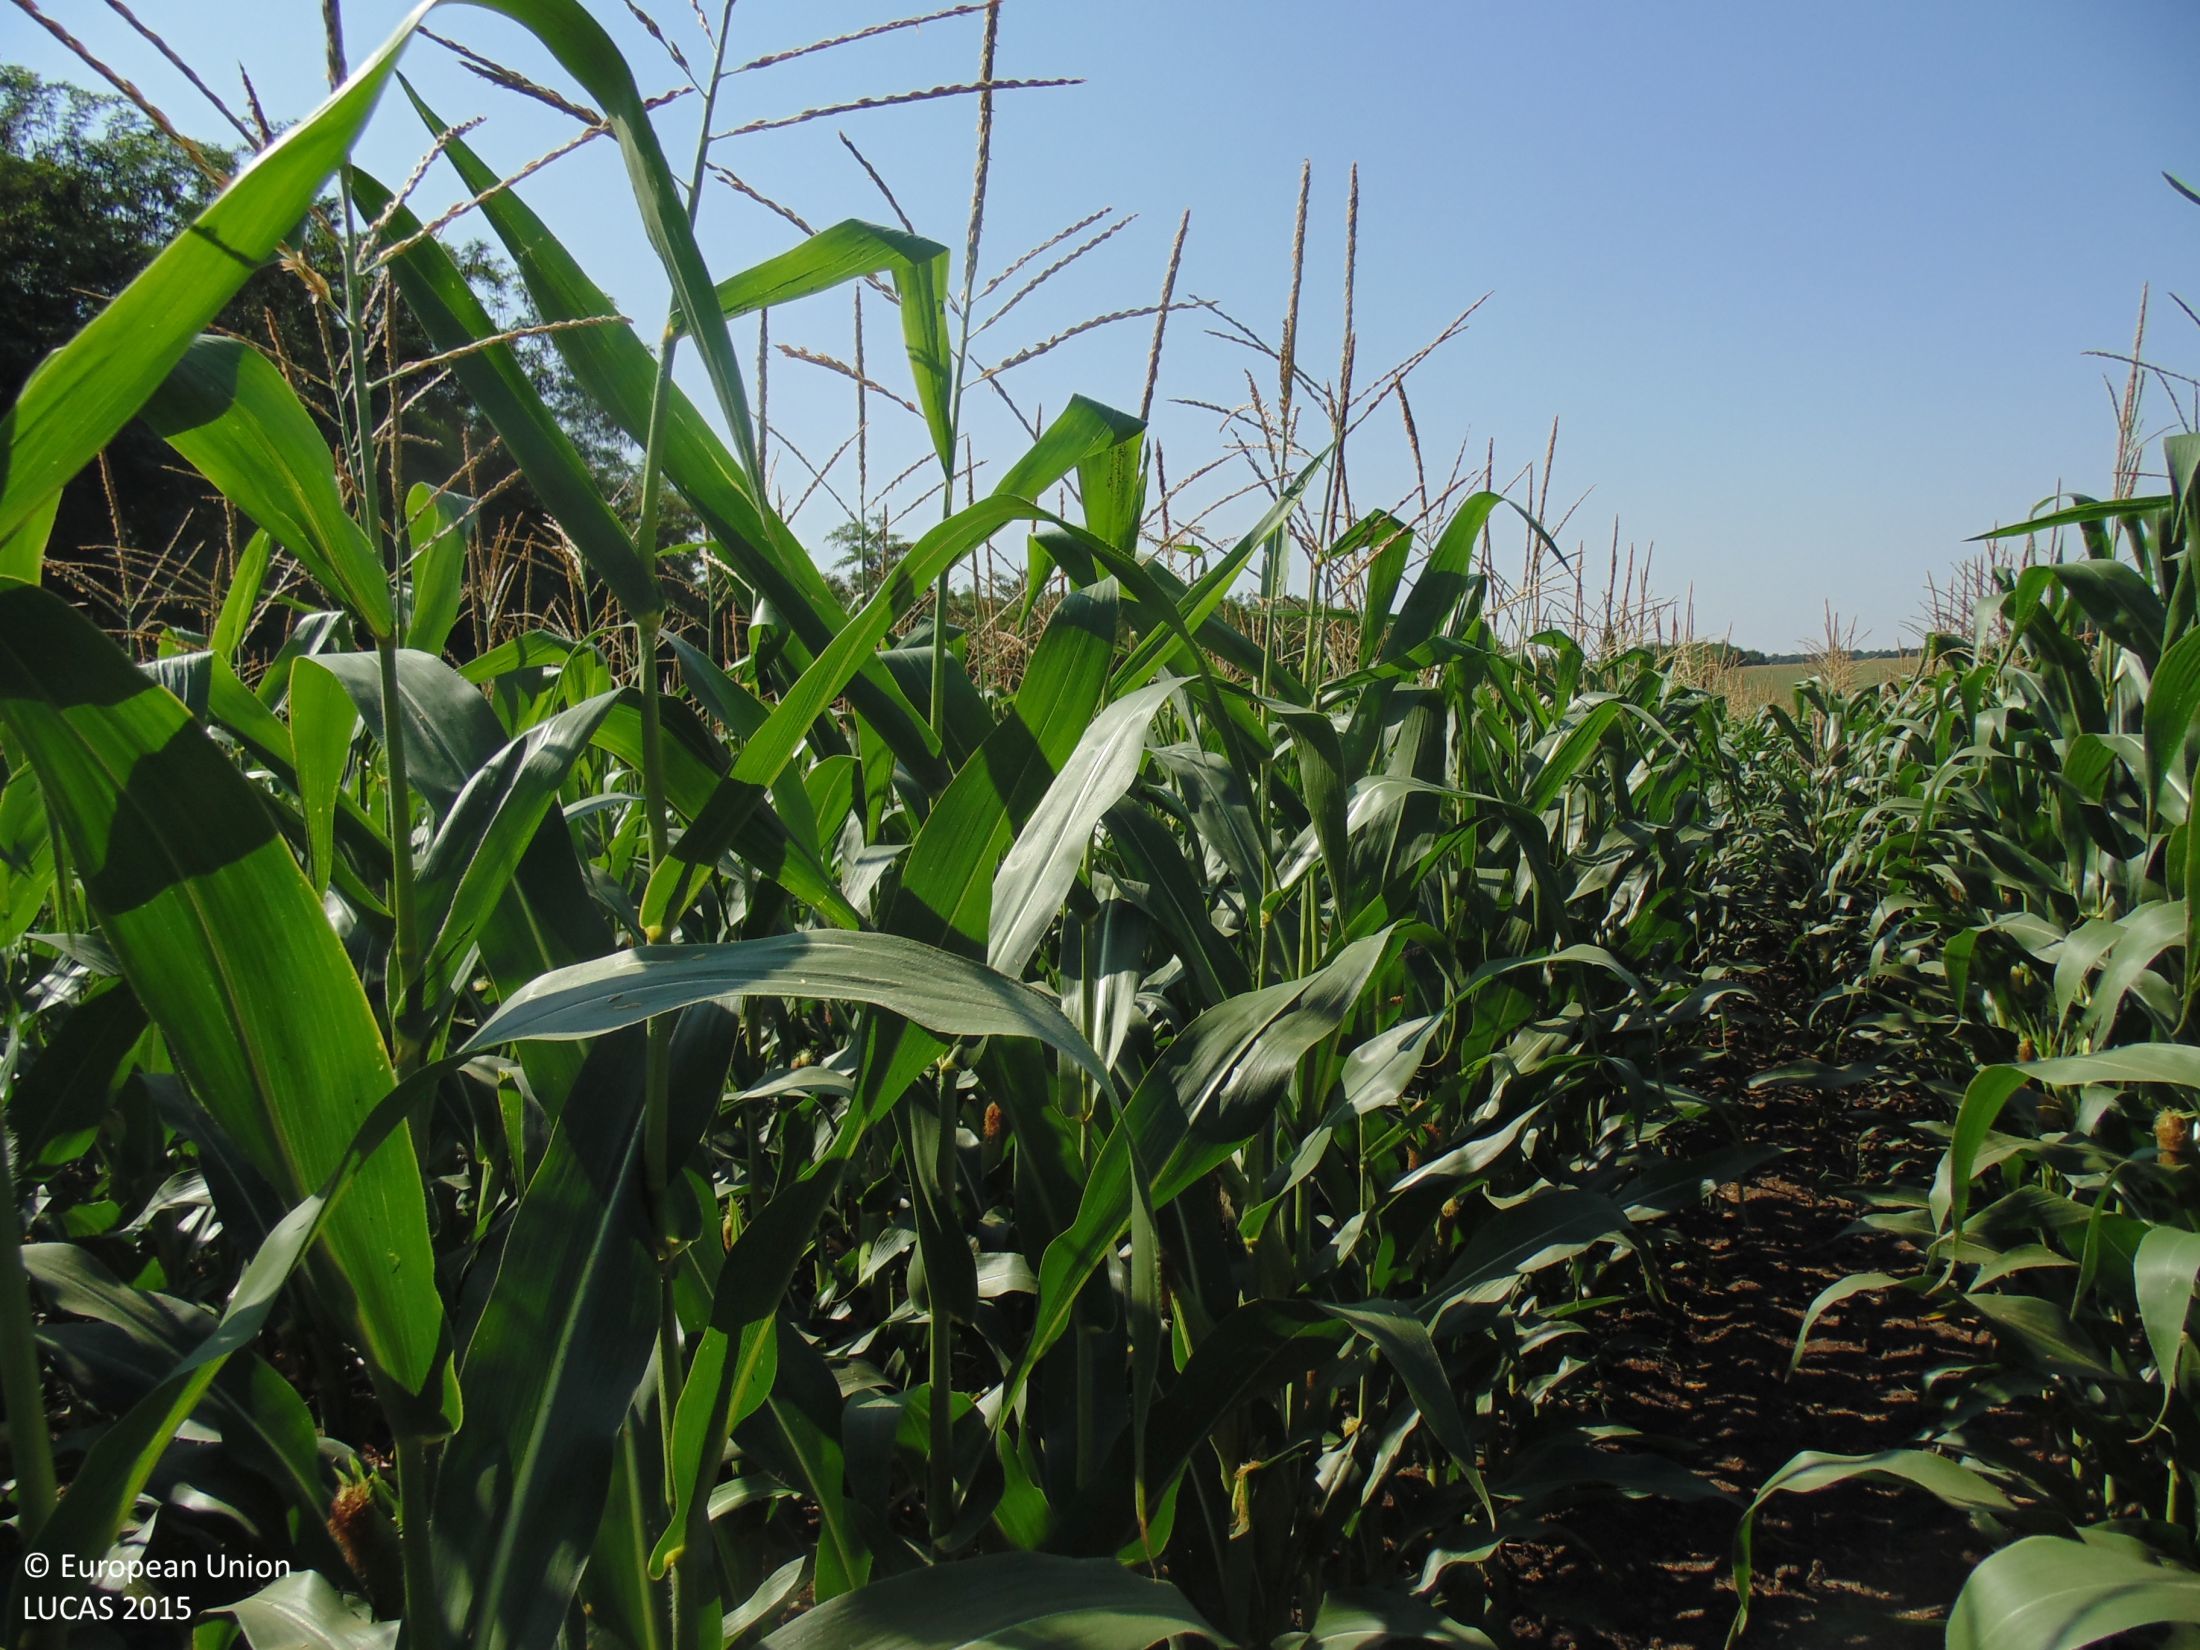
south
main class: Cropland
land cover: Maize
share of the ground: > 75 %
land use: Agriculture (excluding fallow land and kitchen gardens)
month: July
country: BG
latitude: 43.6210
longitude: 27.7235
